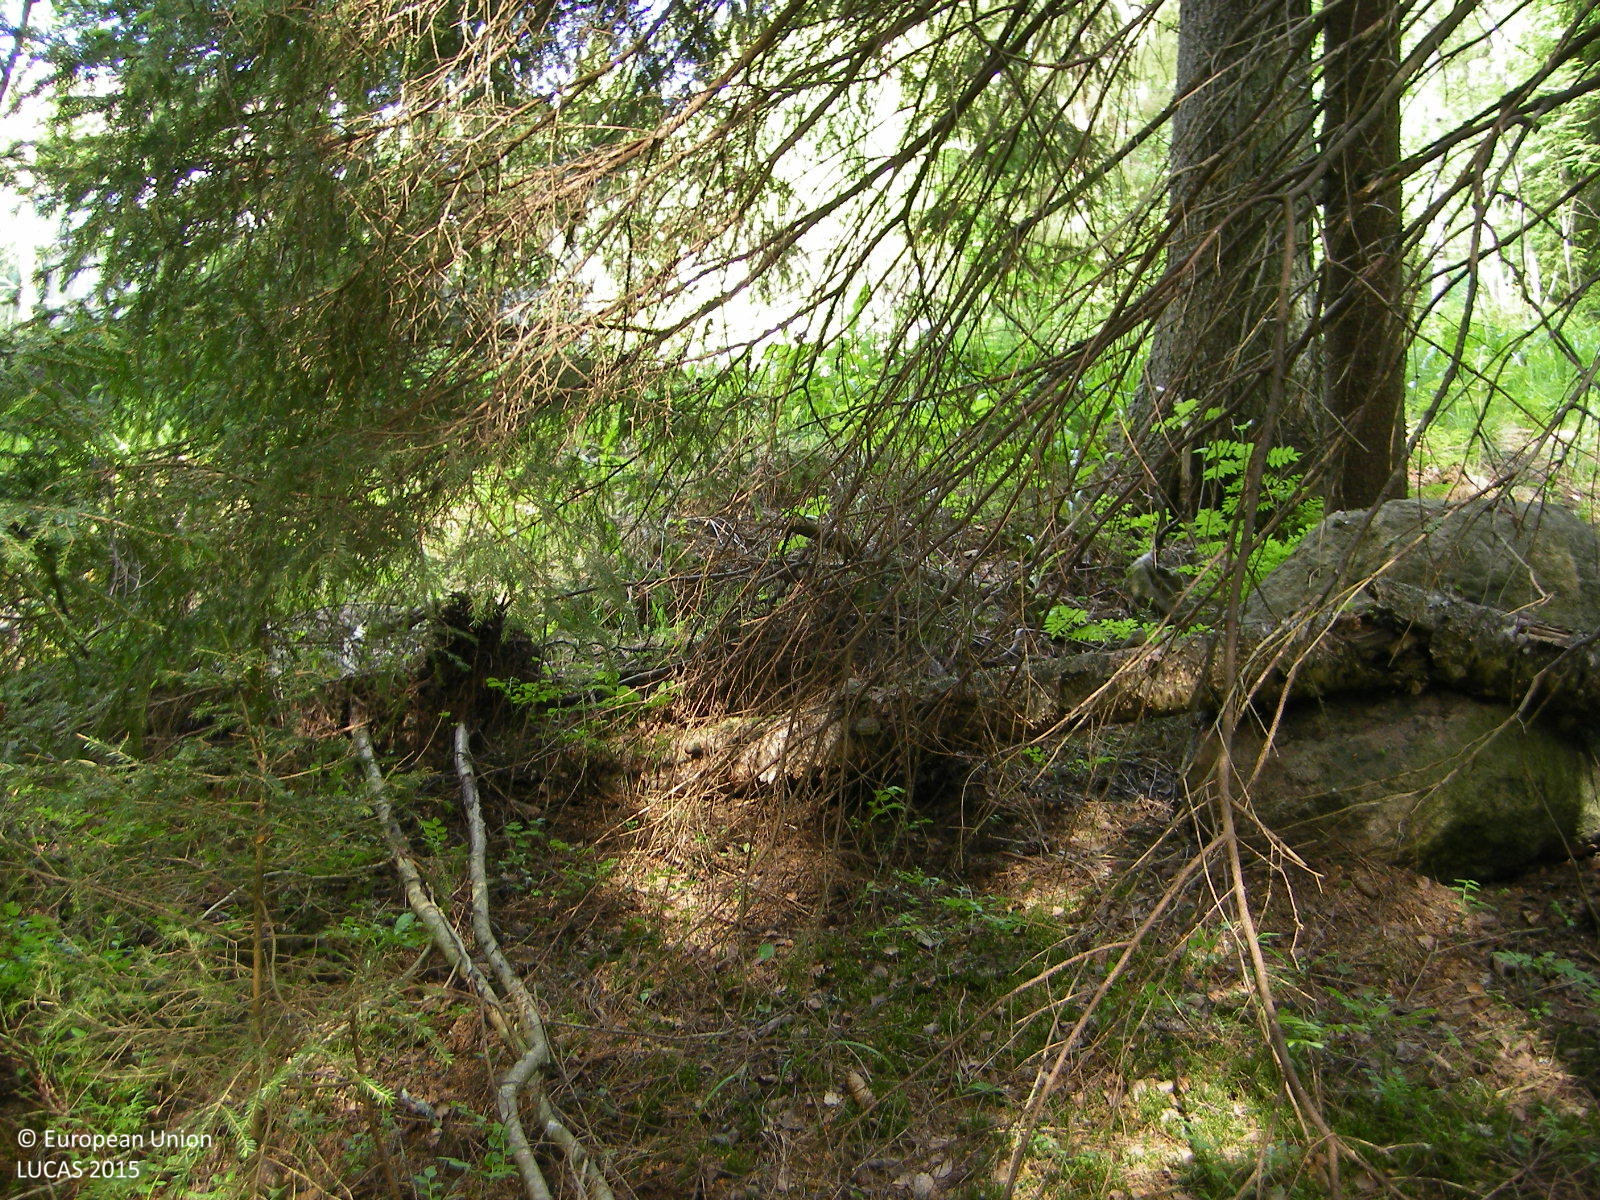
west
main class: Woodland
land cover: Spruce dominated coniferous woodland
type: boreal forest
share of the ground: > 75 %
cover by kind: coniferous forest trees 80 %, broadleaved forest trees 10 %, shrubs 10 %
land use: Forestry
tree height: > 5 m
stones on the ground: < 10 %
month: June
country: FI
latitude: 60.2544
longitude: 24.4724
